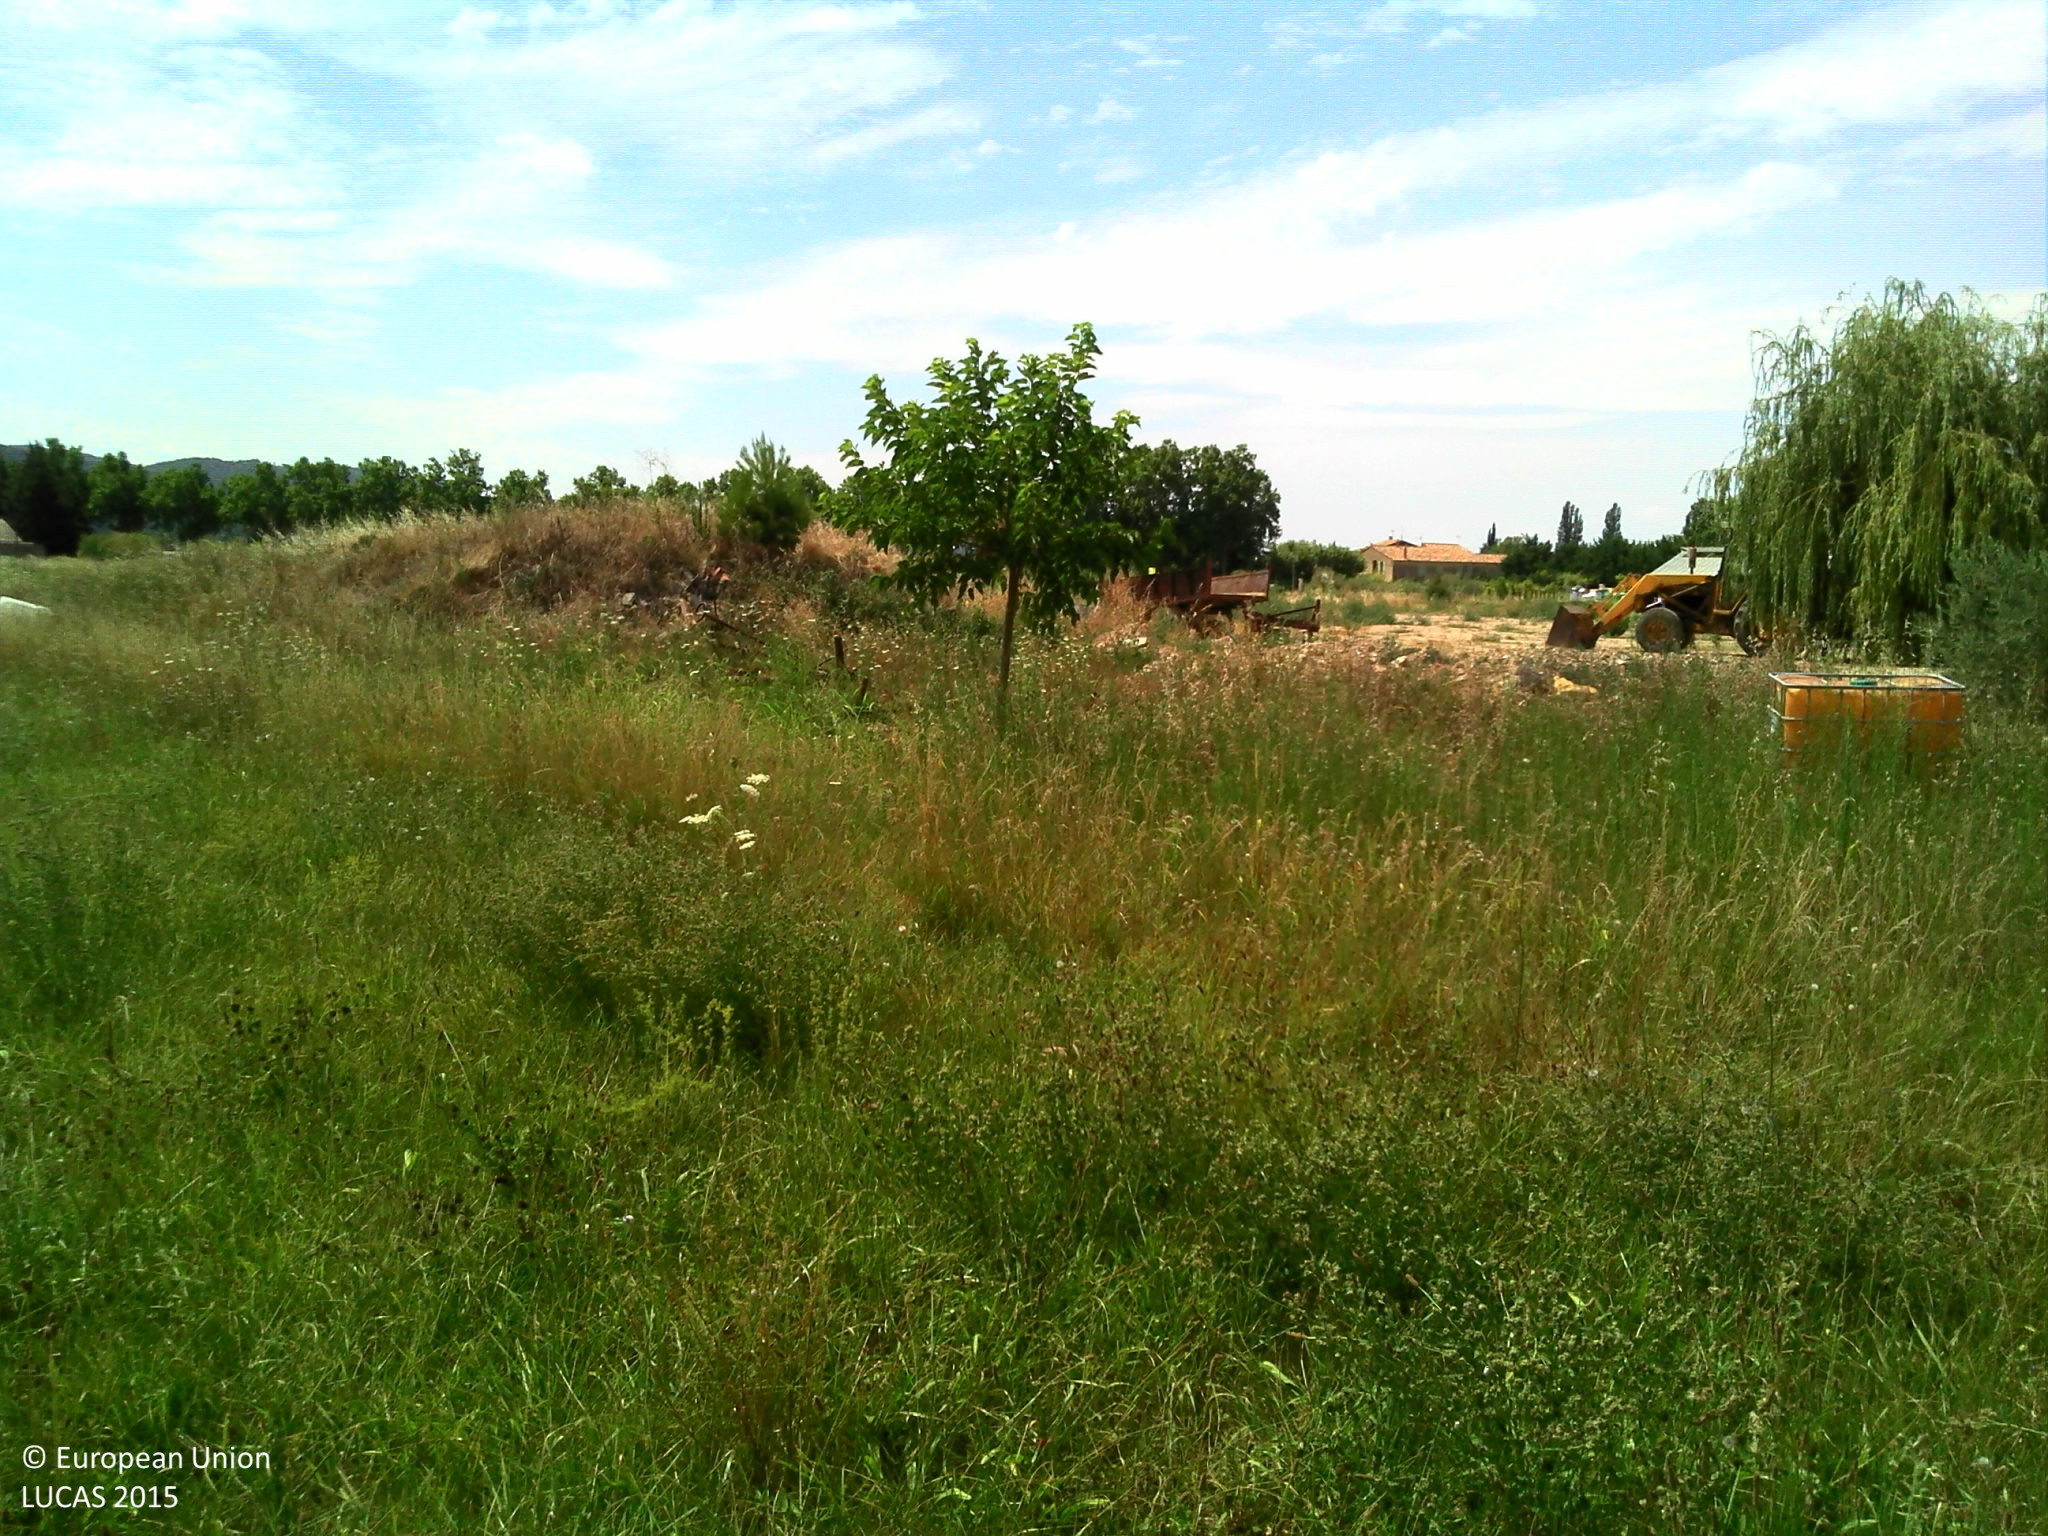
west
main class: Grassland
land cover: Grassland without tree/shrub cover
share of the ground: > 75 %
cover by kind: herbaceous plants 100 %
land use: Agriculture (excluding fallow land and kitchen gardens)
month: July
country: FR
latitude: 43.7237
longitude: 5.3789
